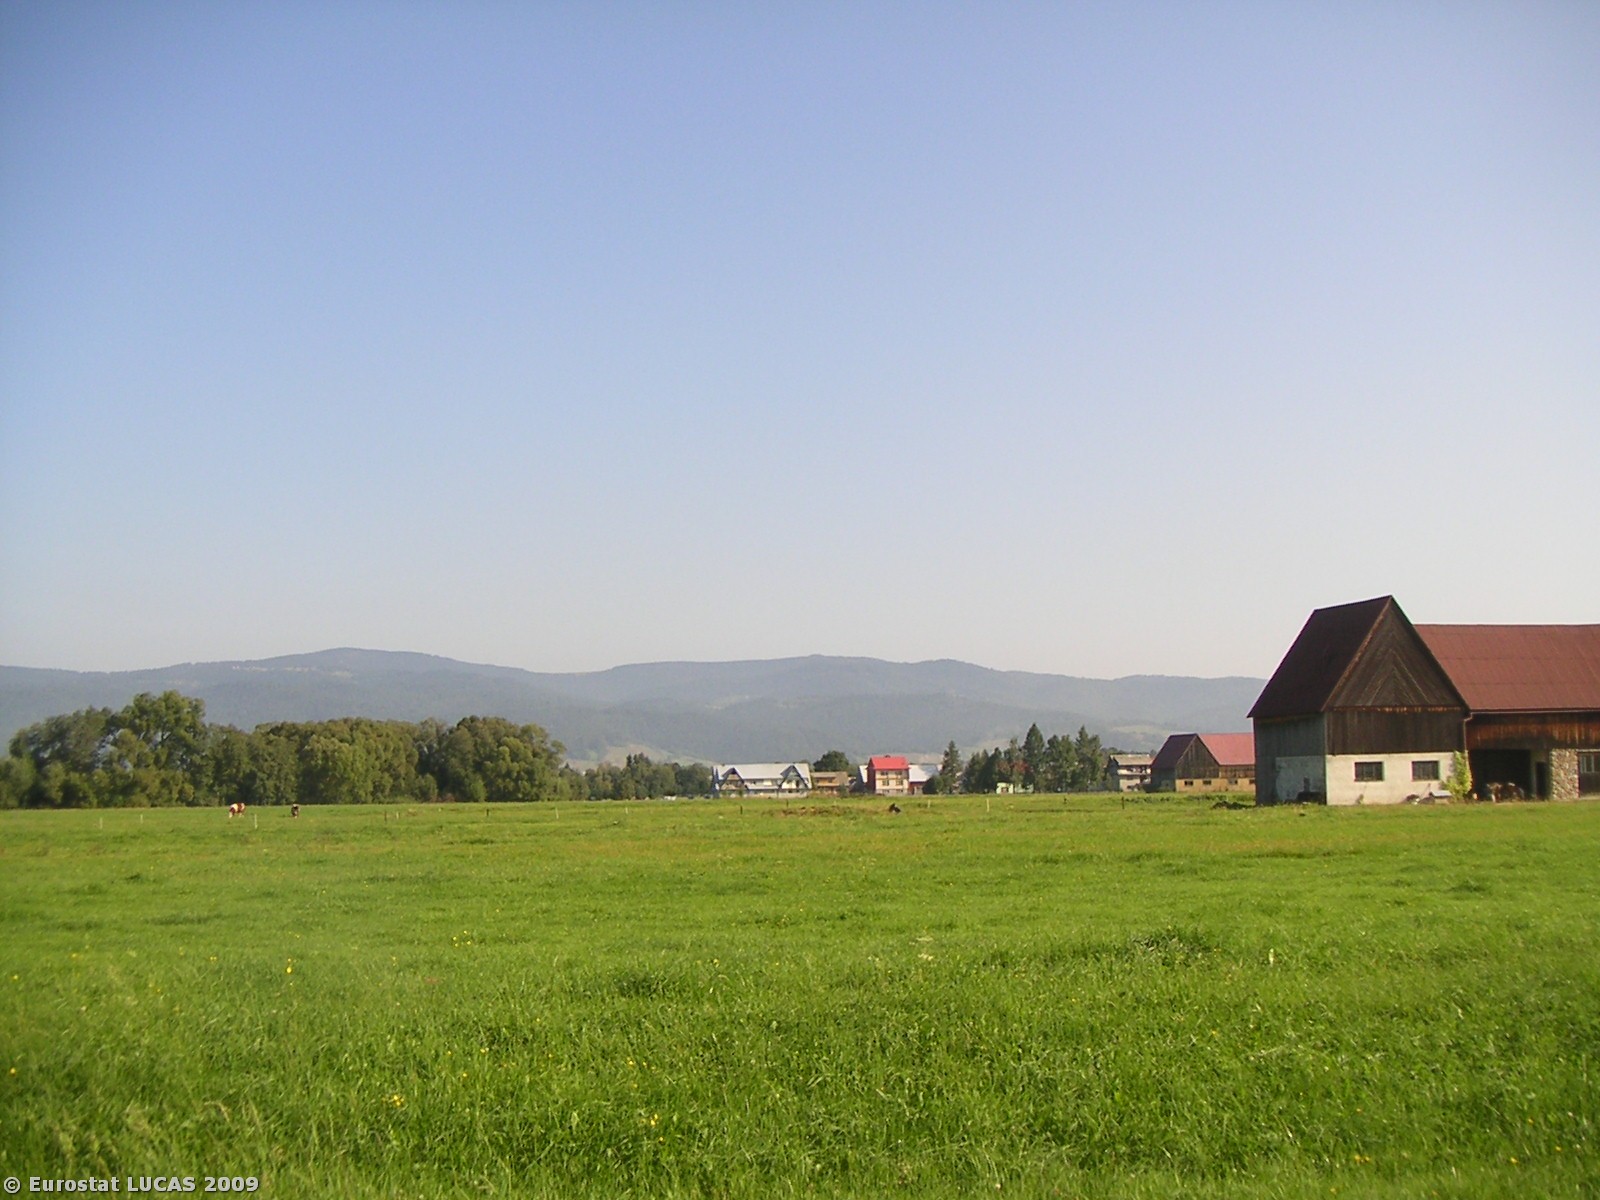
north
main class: Grassland
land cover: Grassland without tree/shrub cover
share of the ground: > 75 %
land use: Agriculture (excluding fallow land and kitchen gardens)
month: September
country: PL
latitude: 49.4457
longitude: 20.0872
